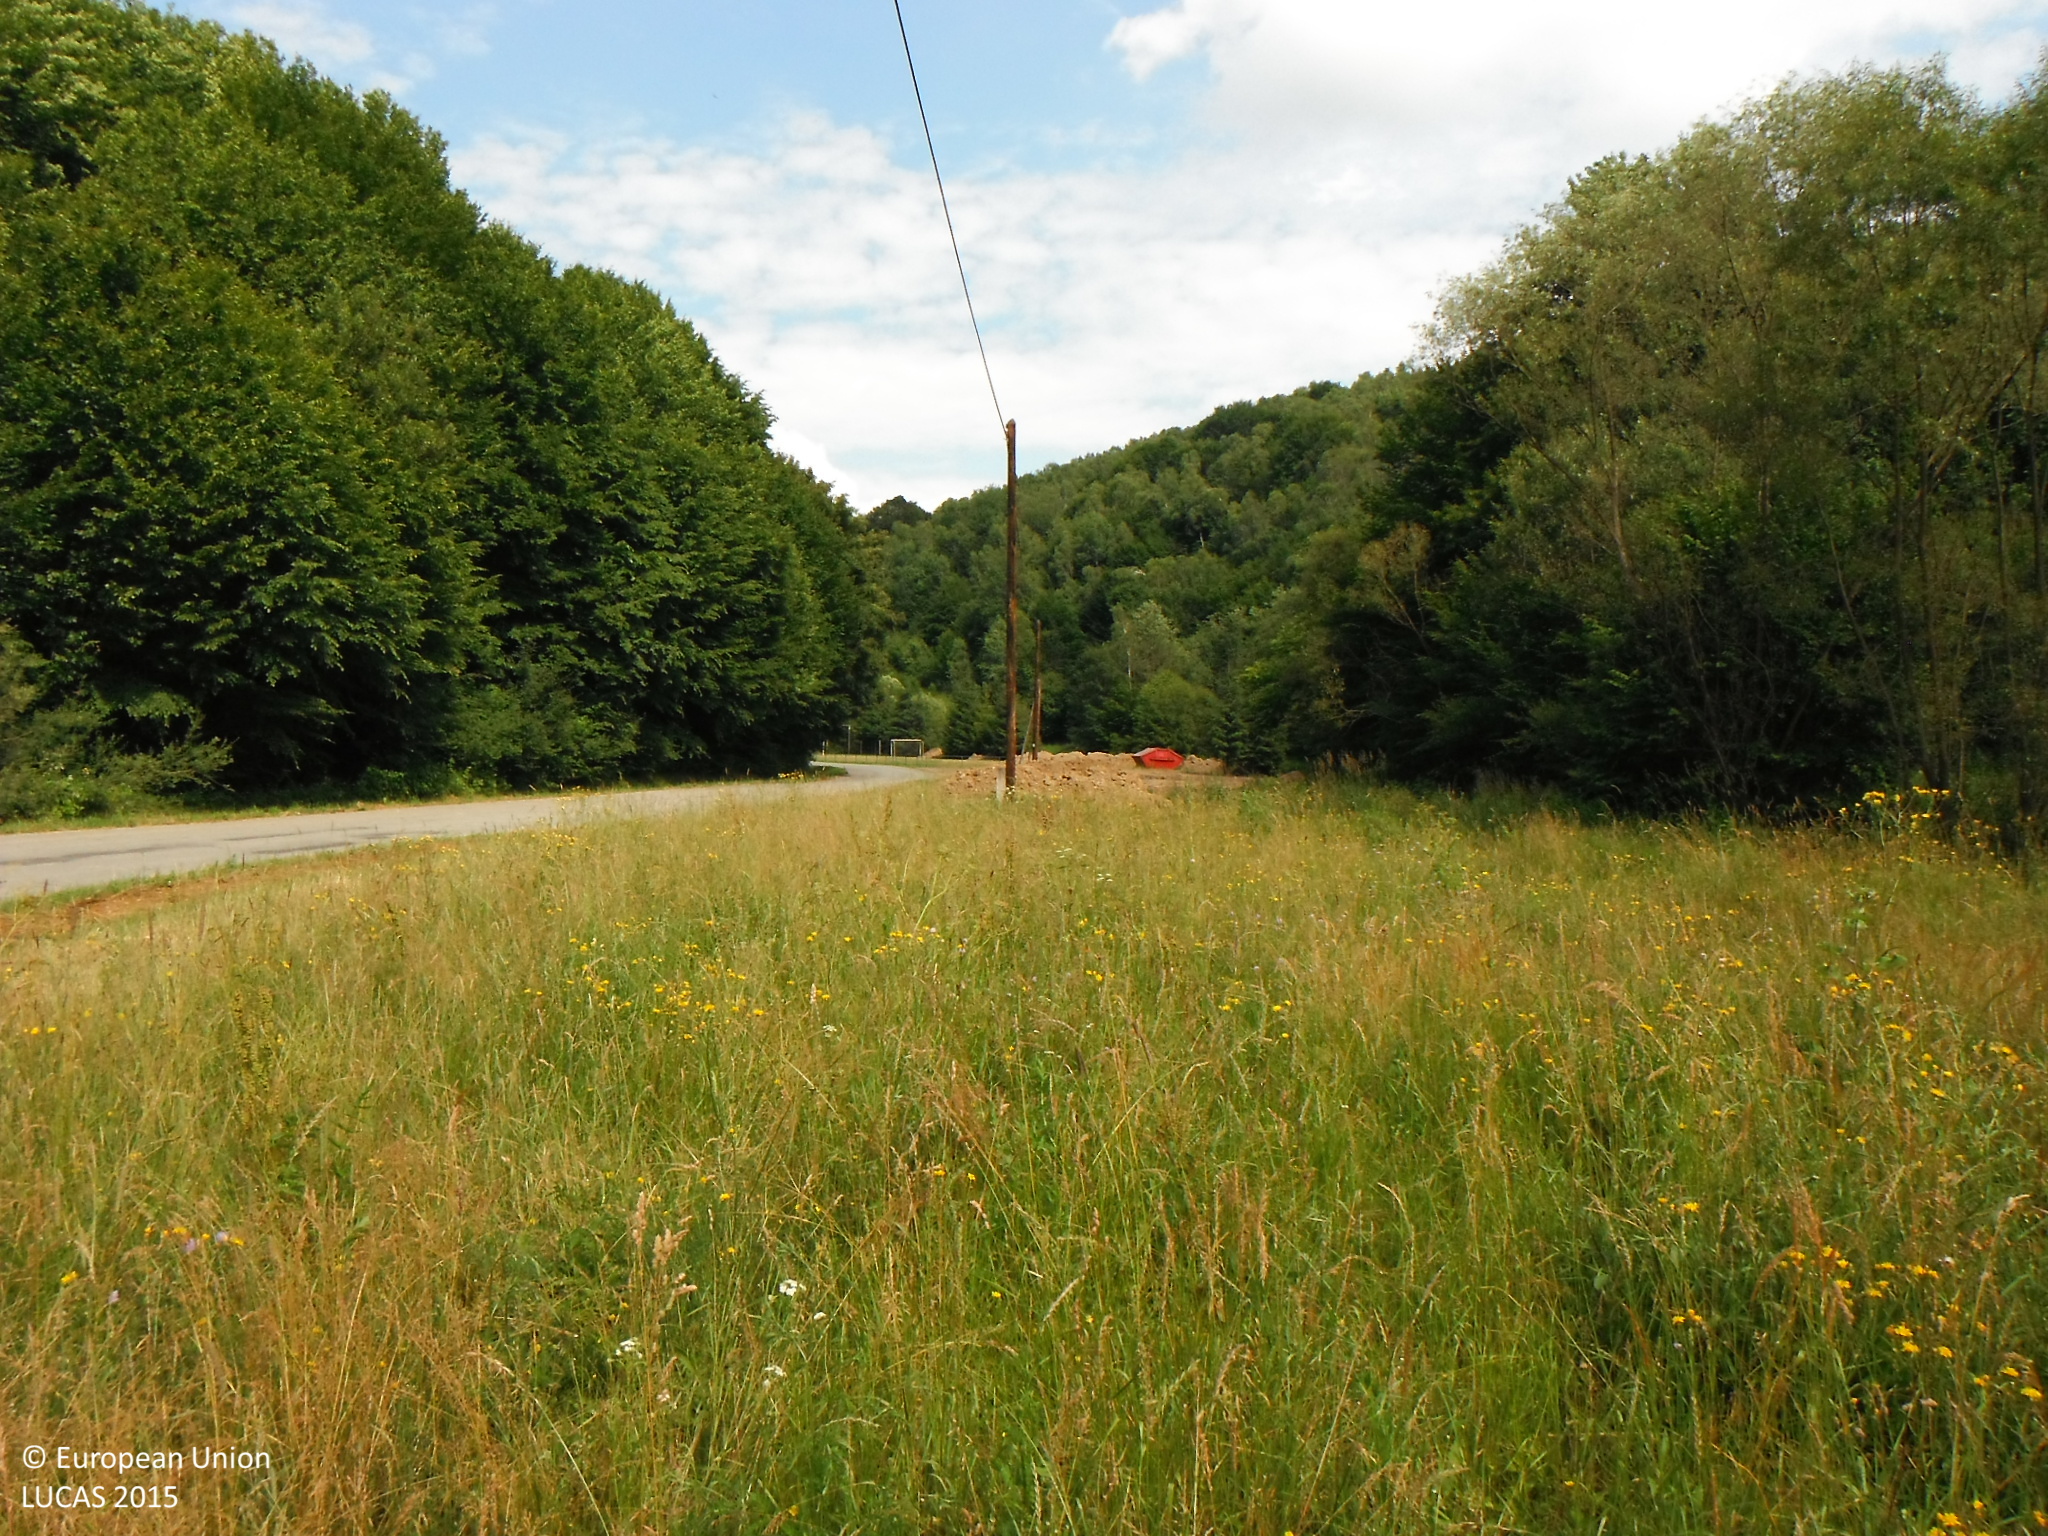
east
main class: Grassland
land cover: Grassland without tree/shrub cover
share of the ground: > 75 %
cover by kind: herbaceous plants 100 %
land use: Agriculture (excluding fallow land and kitchen gardens)
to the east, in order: Grassland without tree/shrub cover; Electric lines; Grassland without tree/shrub cover; Grass margins; Paved roads, cycling and walking lanes; Grass margins; Ditches and canals; Broadleaved woodland; Ditches and canals; Paved roads, cycling and walking lanes; Grass margins; Electric lines; Grassland without tree/shrub cover; Fences; Grassland without tree/shrub cover; Conifer hedges; Rivers and streams; Broadleaved woodland; Fences; Grassland with sparse tree/shrub cover; Fences; Grassland without tree/shrub cover
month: June
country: SK
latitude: 49.3478
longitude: 21.6554
